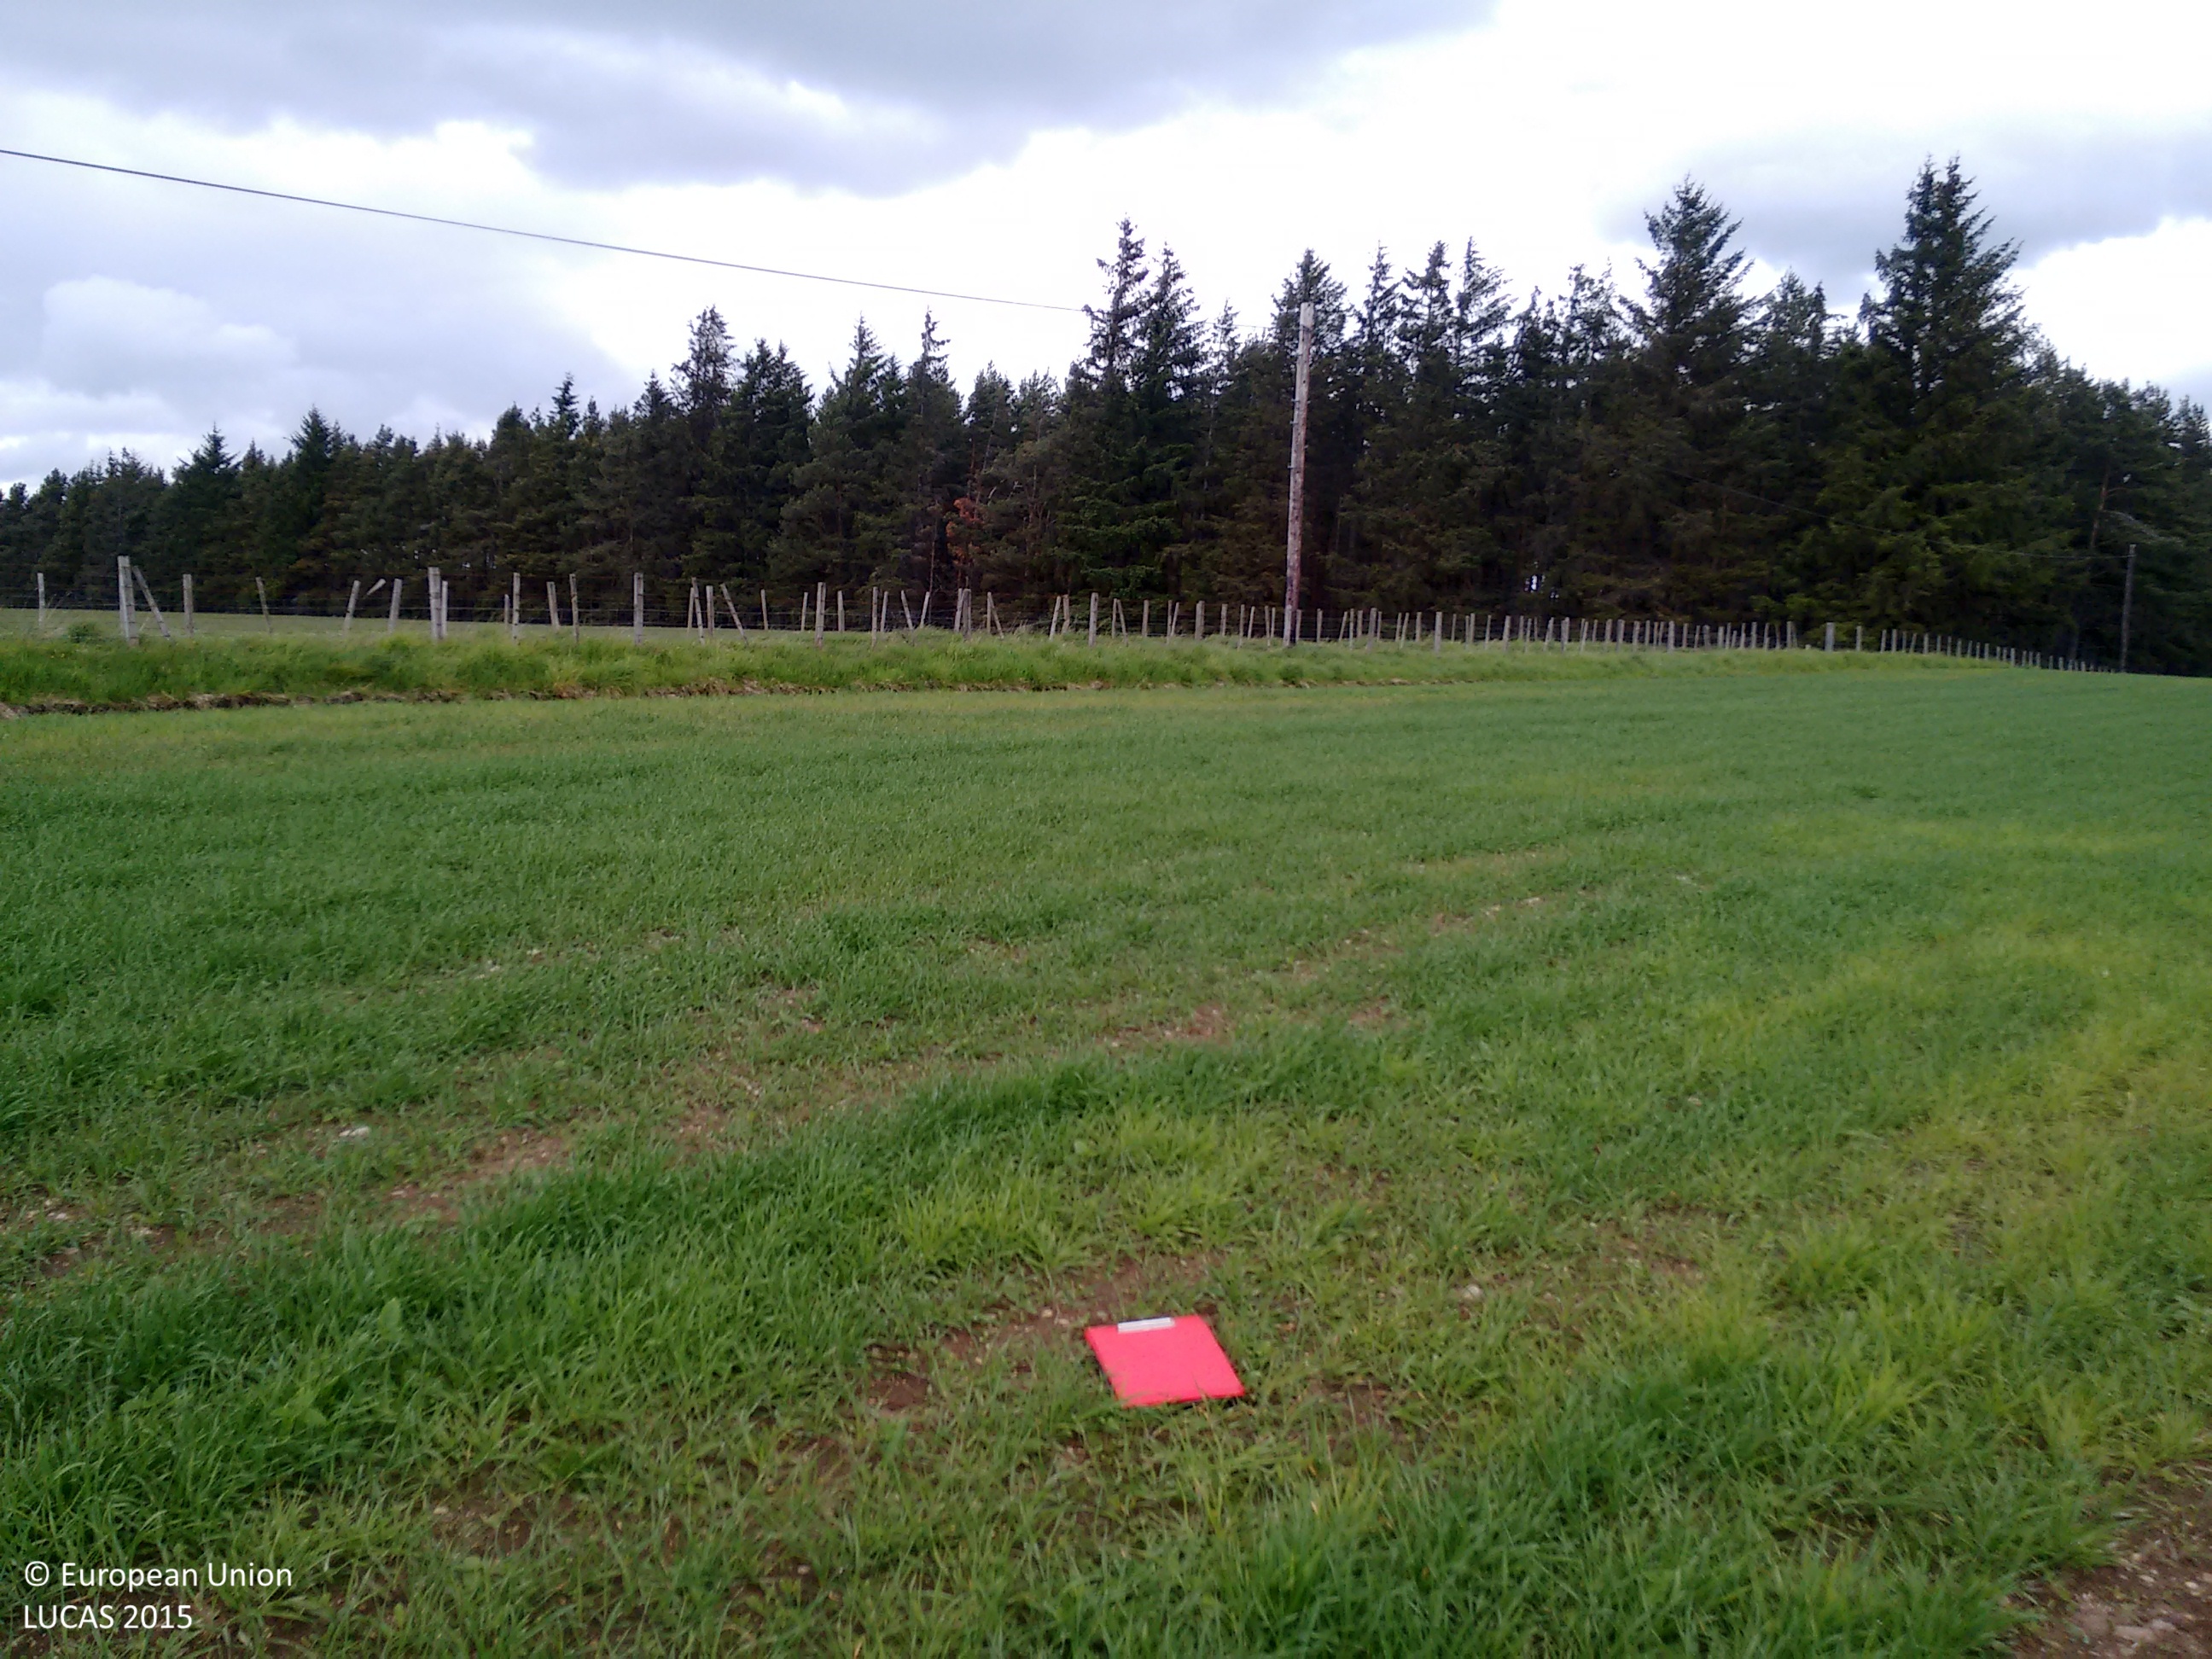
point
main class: Cropland
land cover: Barley
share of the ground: > 75 %
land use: Agriculture (excluding fallow land and kitchen gardens)
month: June
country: GB
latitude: 57.2134
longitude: -3.7702
